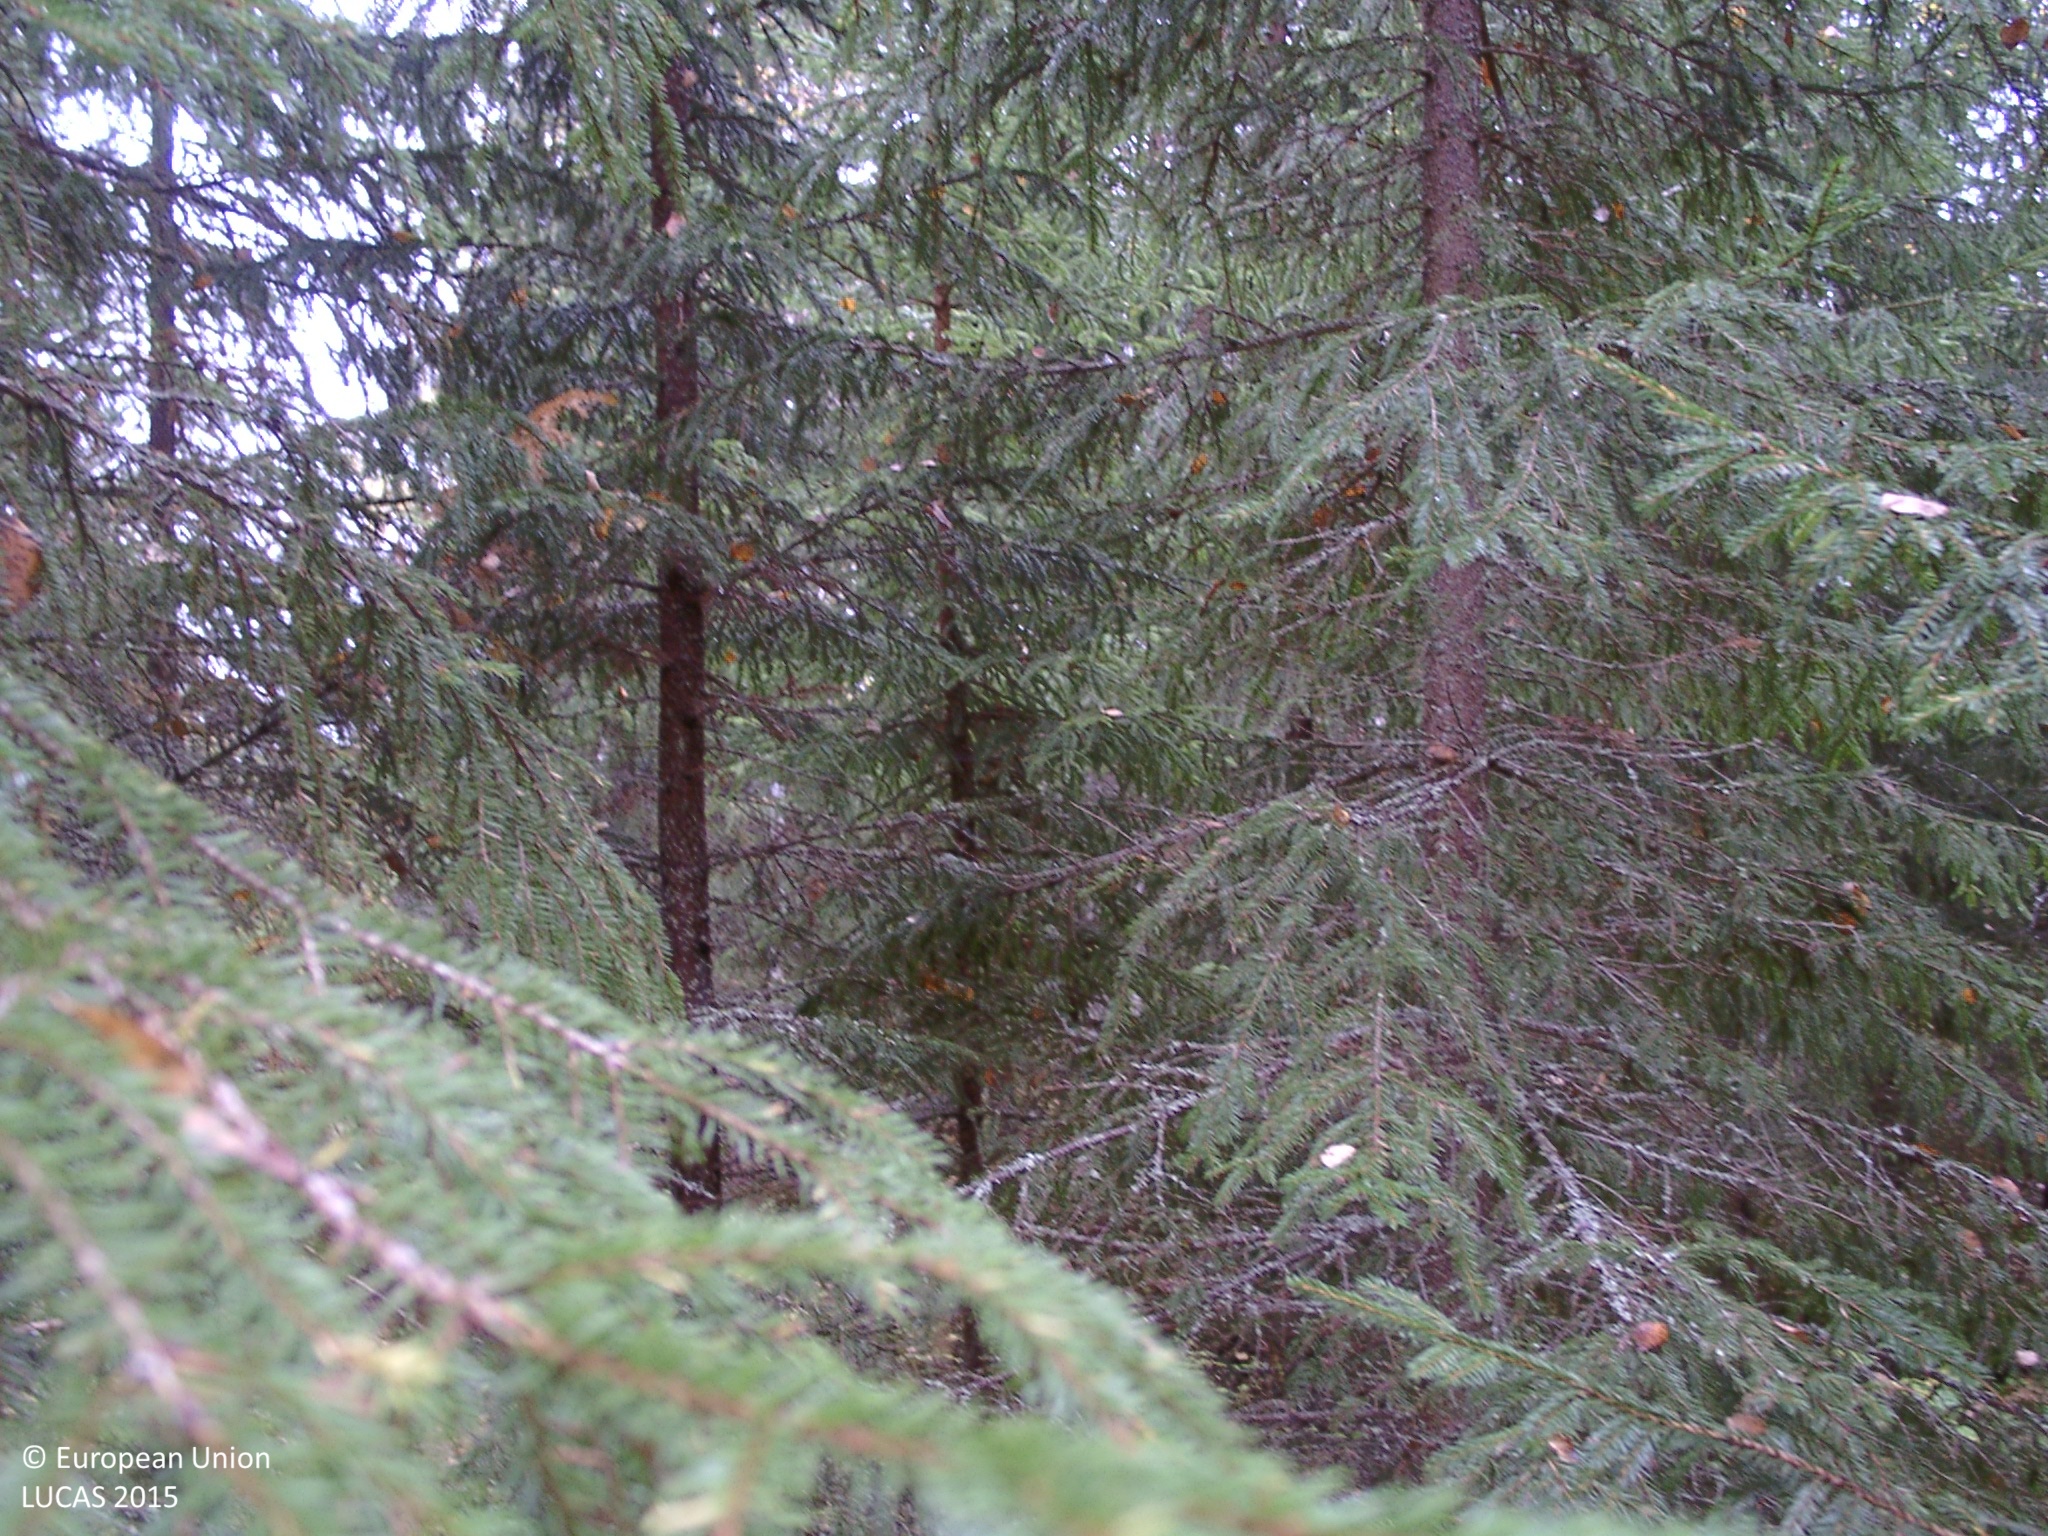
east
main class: Woodland
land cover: Other mixed woodland
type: boreal forest
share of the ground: 50 - 75 %
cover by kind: coniferous forest trees 45 %, broadleaved forest trees 25 %, shrubs 10 %, herbaceous plants 10 %, lichens and mosses 10 %
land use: Forestry
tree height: > 5 m
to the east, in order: Other mixed woodland; Ditches and canals; Other mixed woodland; Ditches and canals; Other mixed woodland; Other coniferous woodland; Pine dominated coniferous woodland; Ditches and canals; Managed hedges; Tracks; Managed hedges; Groves
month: September
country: FI
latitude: 62.6831
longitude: 25.7217
